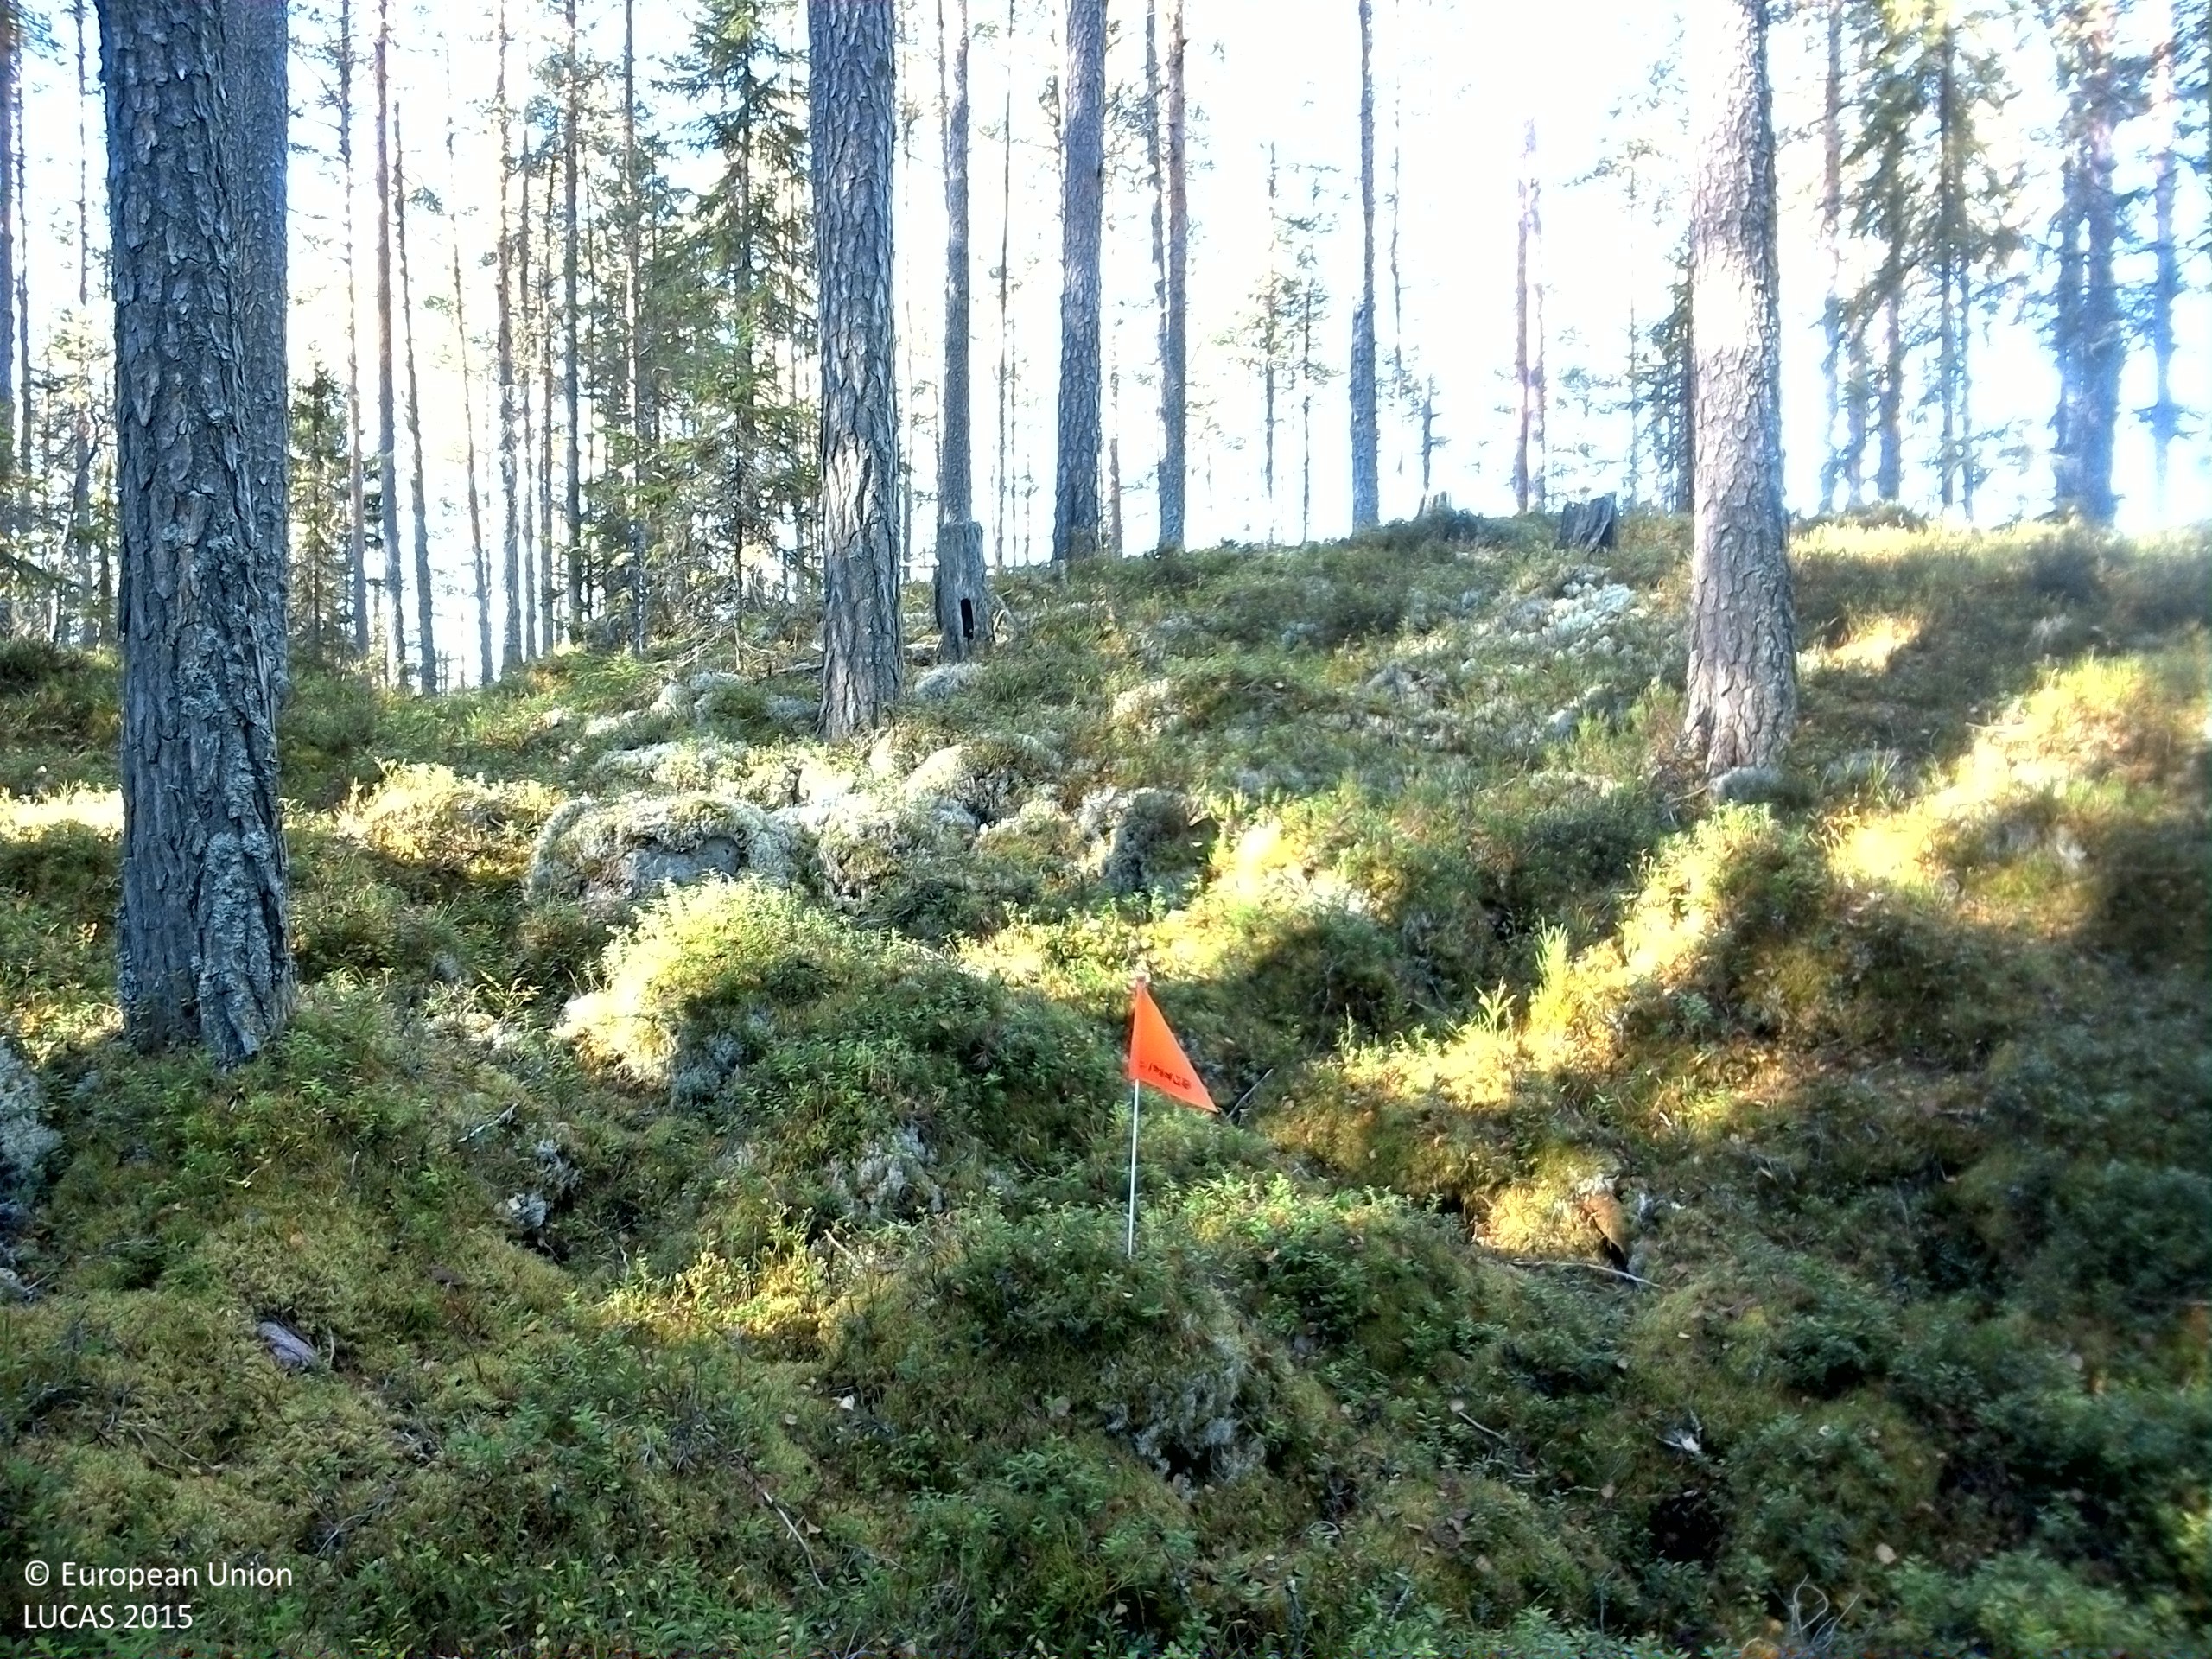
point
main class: Woodland
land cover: Pine dominated coniferous woodland
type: boreal forest
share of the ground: > 75 %
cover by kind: coniferous forest trees 75 %, shrubs 15 %, lichens and mosses 10 %
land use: Forestry
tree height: > 5 m
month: October
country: SE
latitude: 61.1427
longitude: 14.3143
